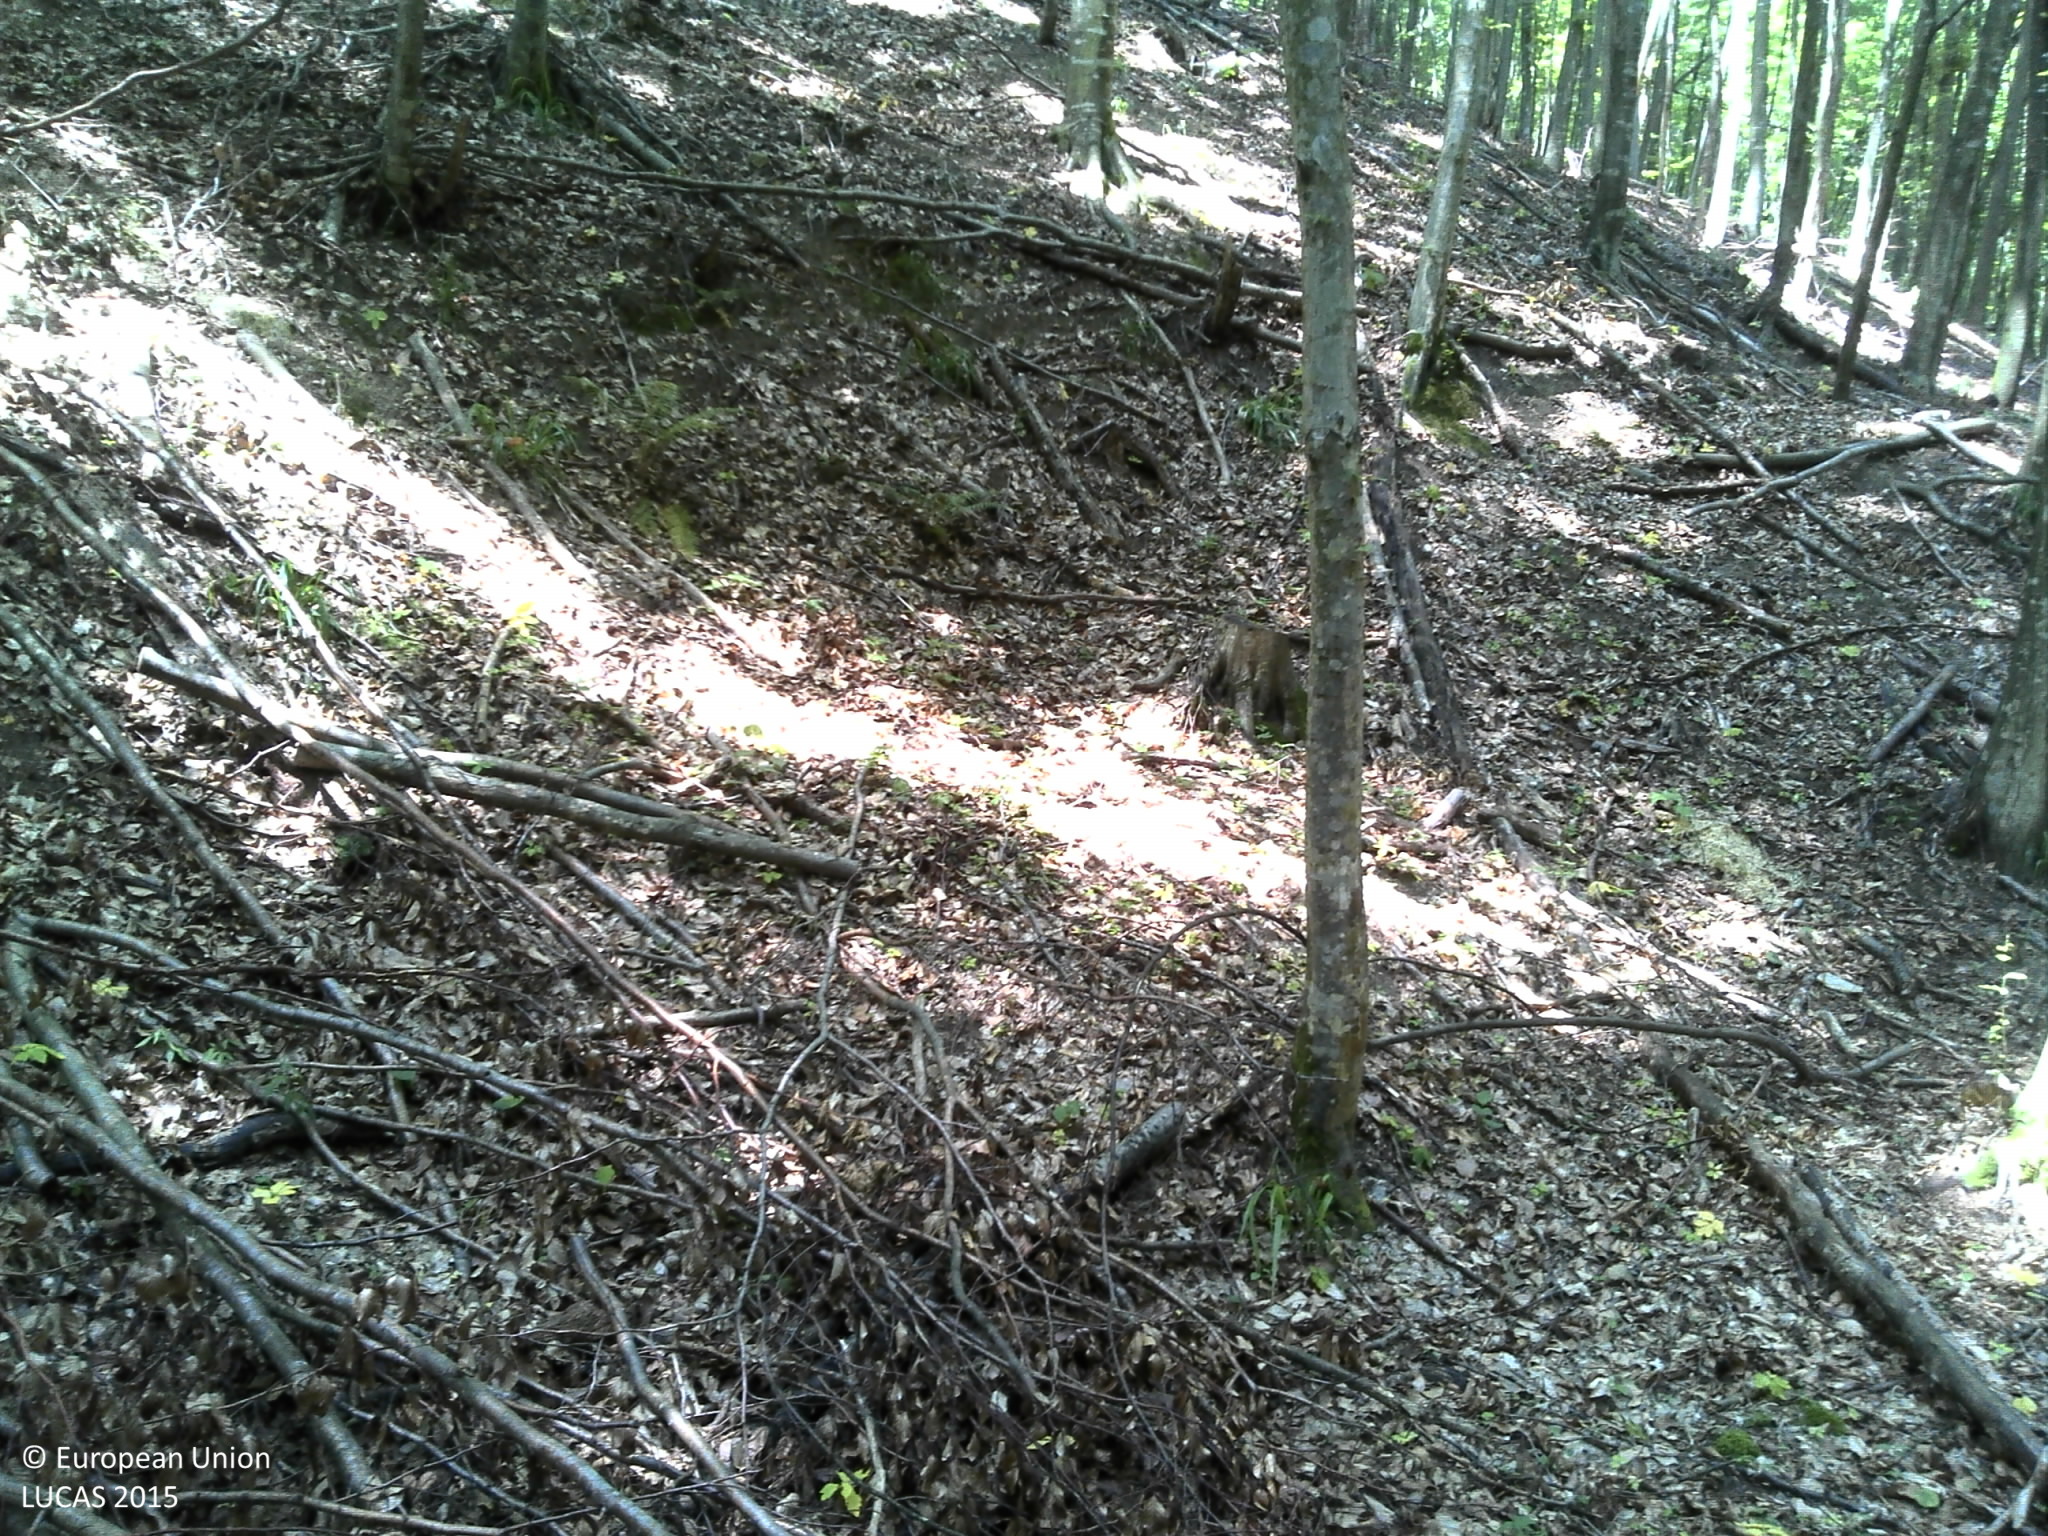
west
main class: Woodland
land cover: Broadleaved woodland
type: acidophilous oak and oak-birch forest
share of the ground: > 75 %
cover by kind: broadleaved forest trees 90 %, shrubs 5 %, herbaceous plants 5 %
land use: Forestry
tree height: > 5 m
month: July
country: HR
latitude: 45.6915
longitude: 16.6639
